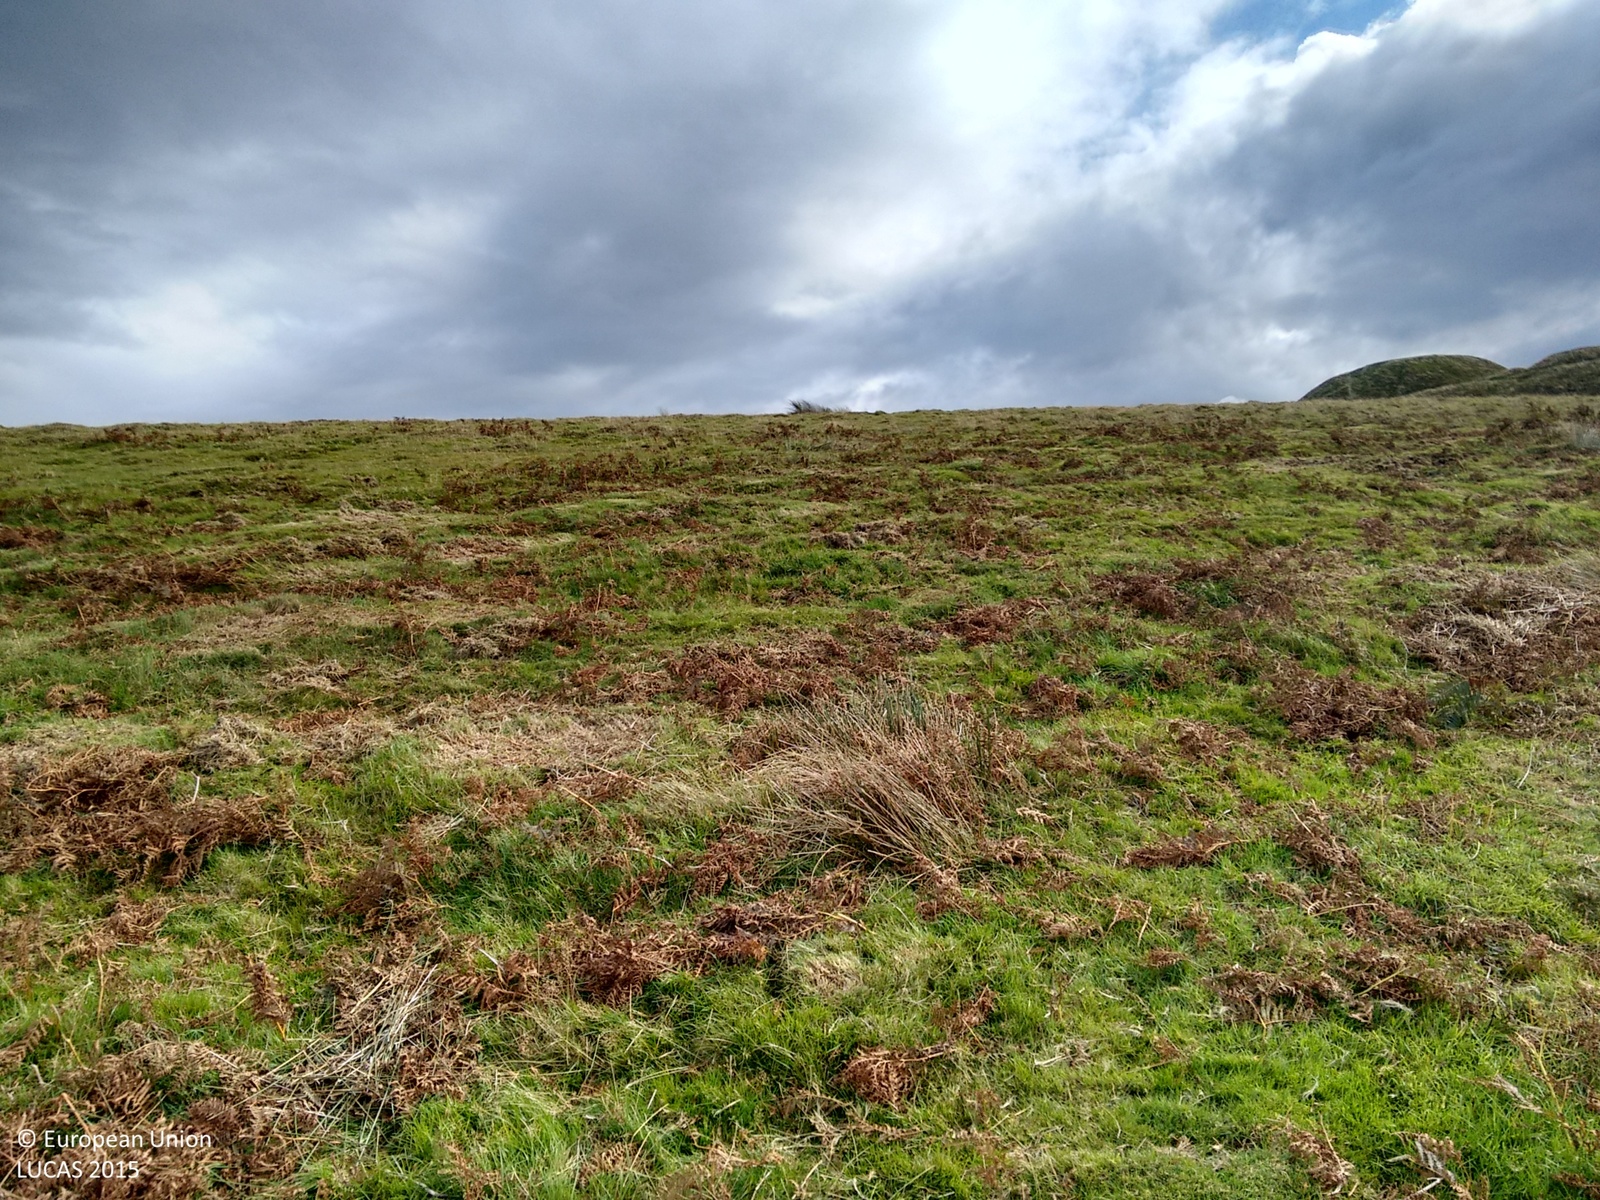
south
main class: Grassland
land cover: Grassland without tree/shrub cover
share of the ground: > 75 %
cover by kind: herbaceous plants 100 %
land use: Agriculture (excluding fallow land and kitchen gardens)
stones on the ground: < 10 %
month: September
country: GB
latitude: 51.6300
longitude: -3.0933
